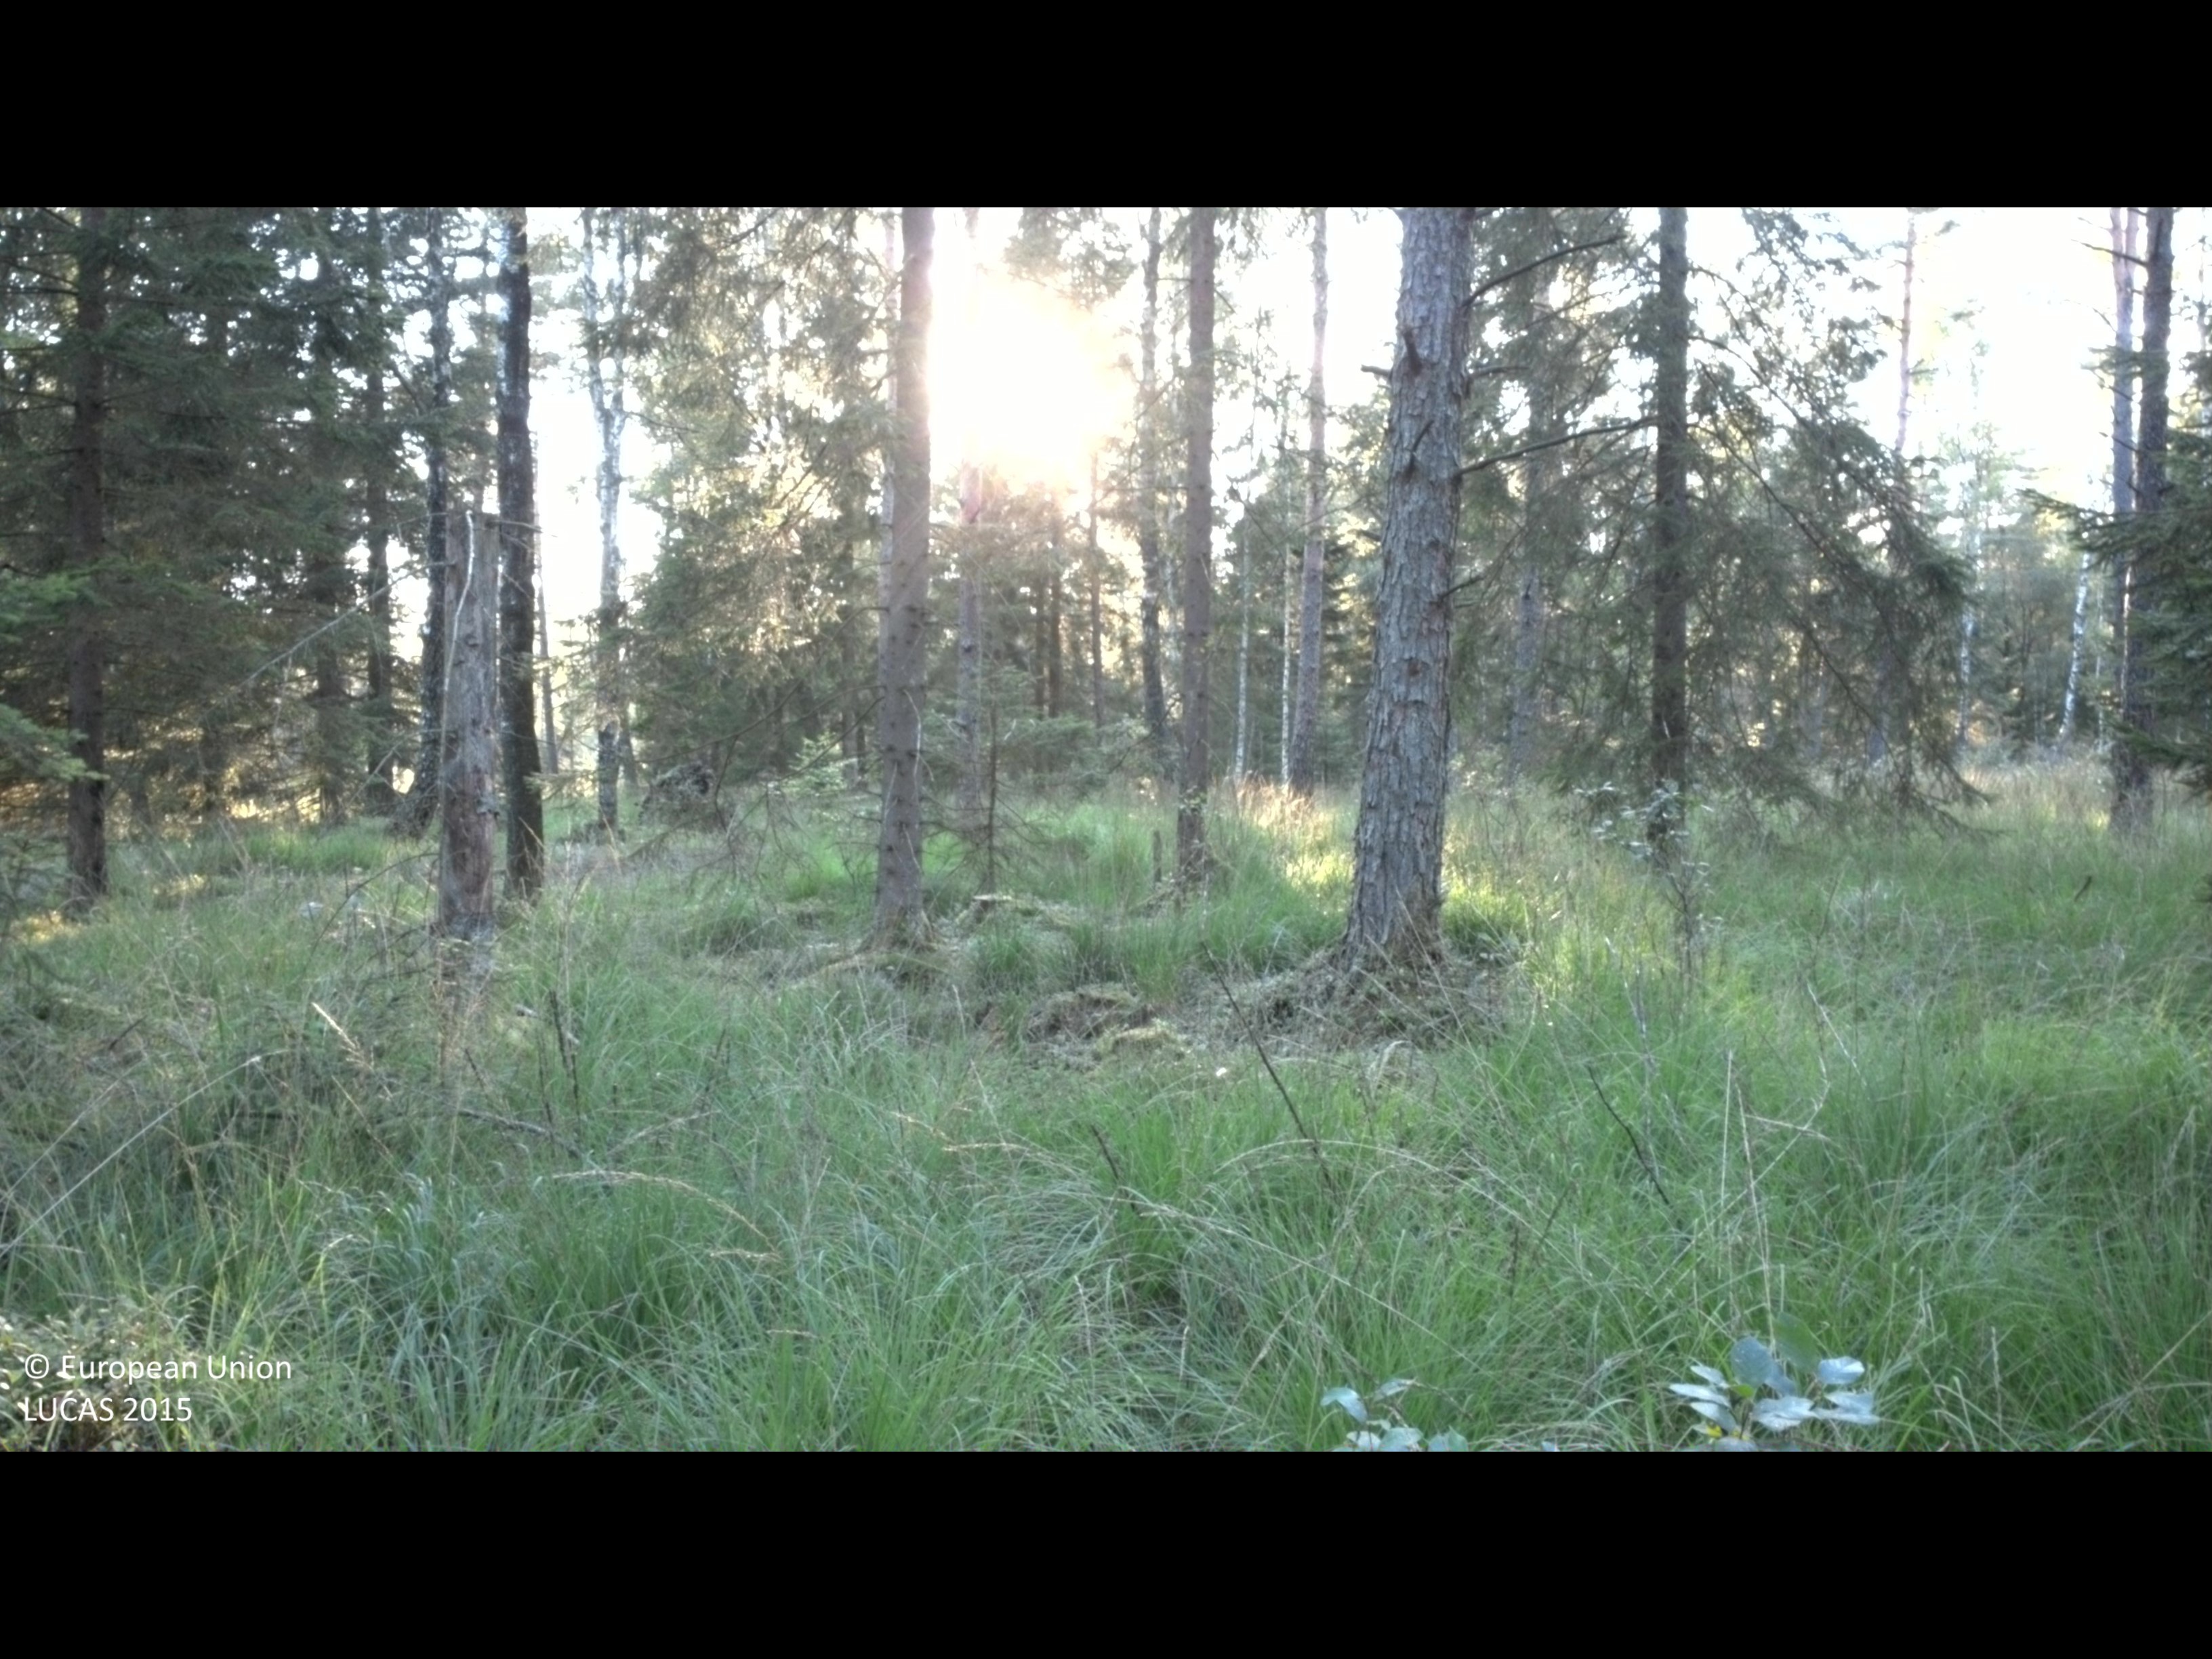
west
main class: Woodland
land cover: Pine dominated mixed woodland
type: boreal forest
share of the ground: 50 - 75 %
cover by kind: coniferous forest trees 45 %, herbaceous plants 30 %, broadleaved forest trees 15 %, shrubs 10 %
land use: Forestry
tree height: > 5 m
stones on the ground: < 10 %
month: August
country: SE
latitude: 56.7428
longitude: 13.1523
